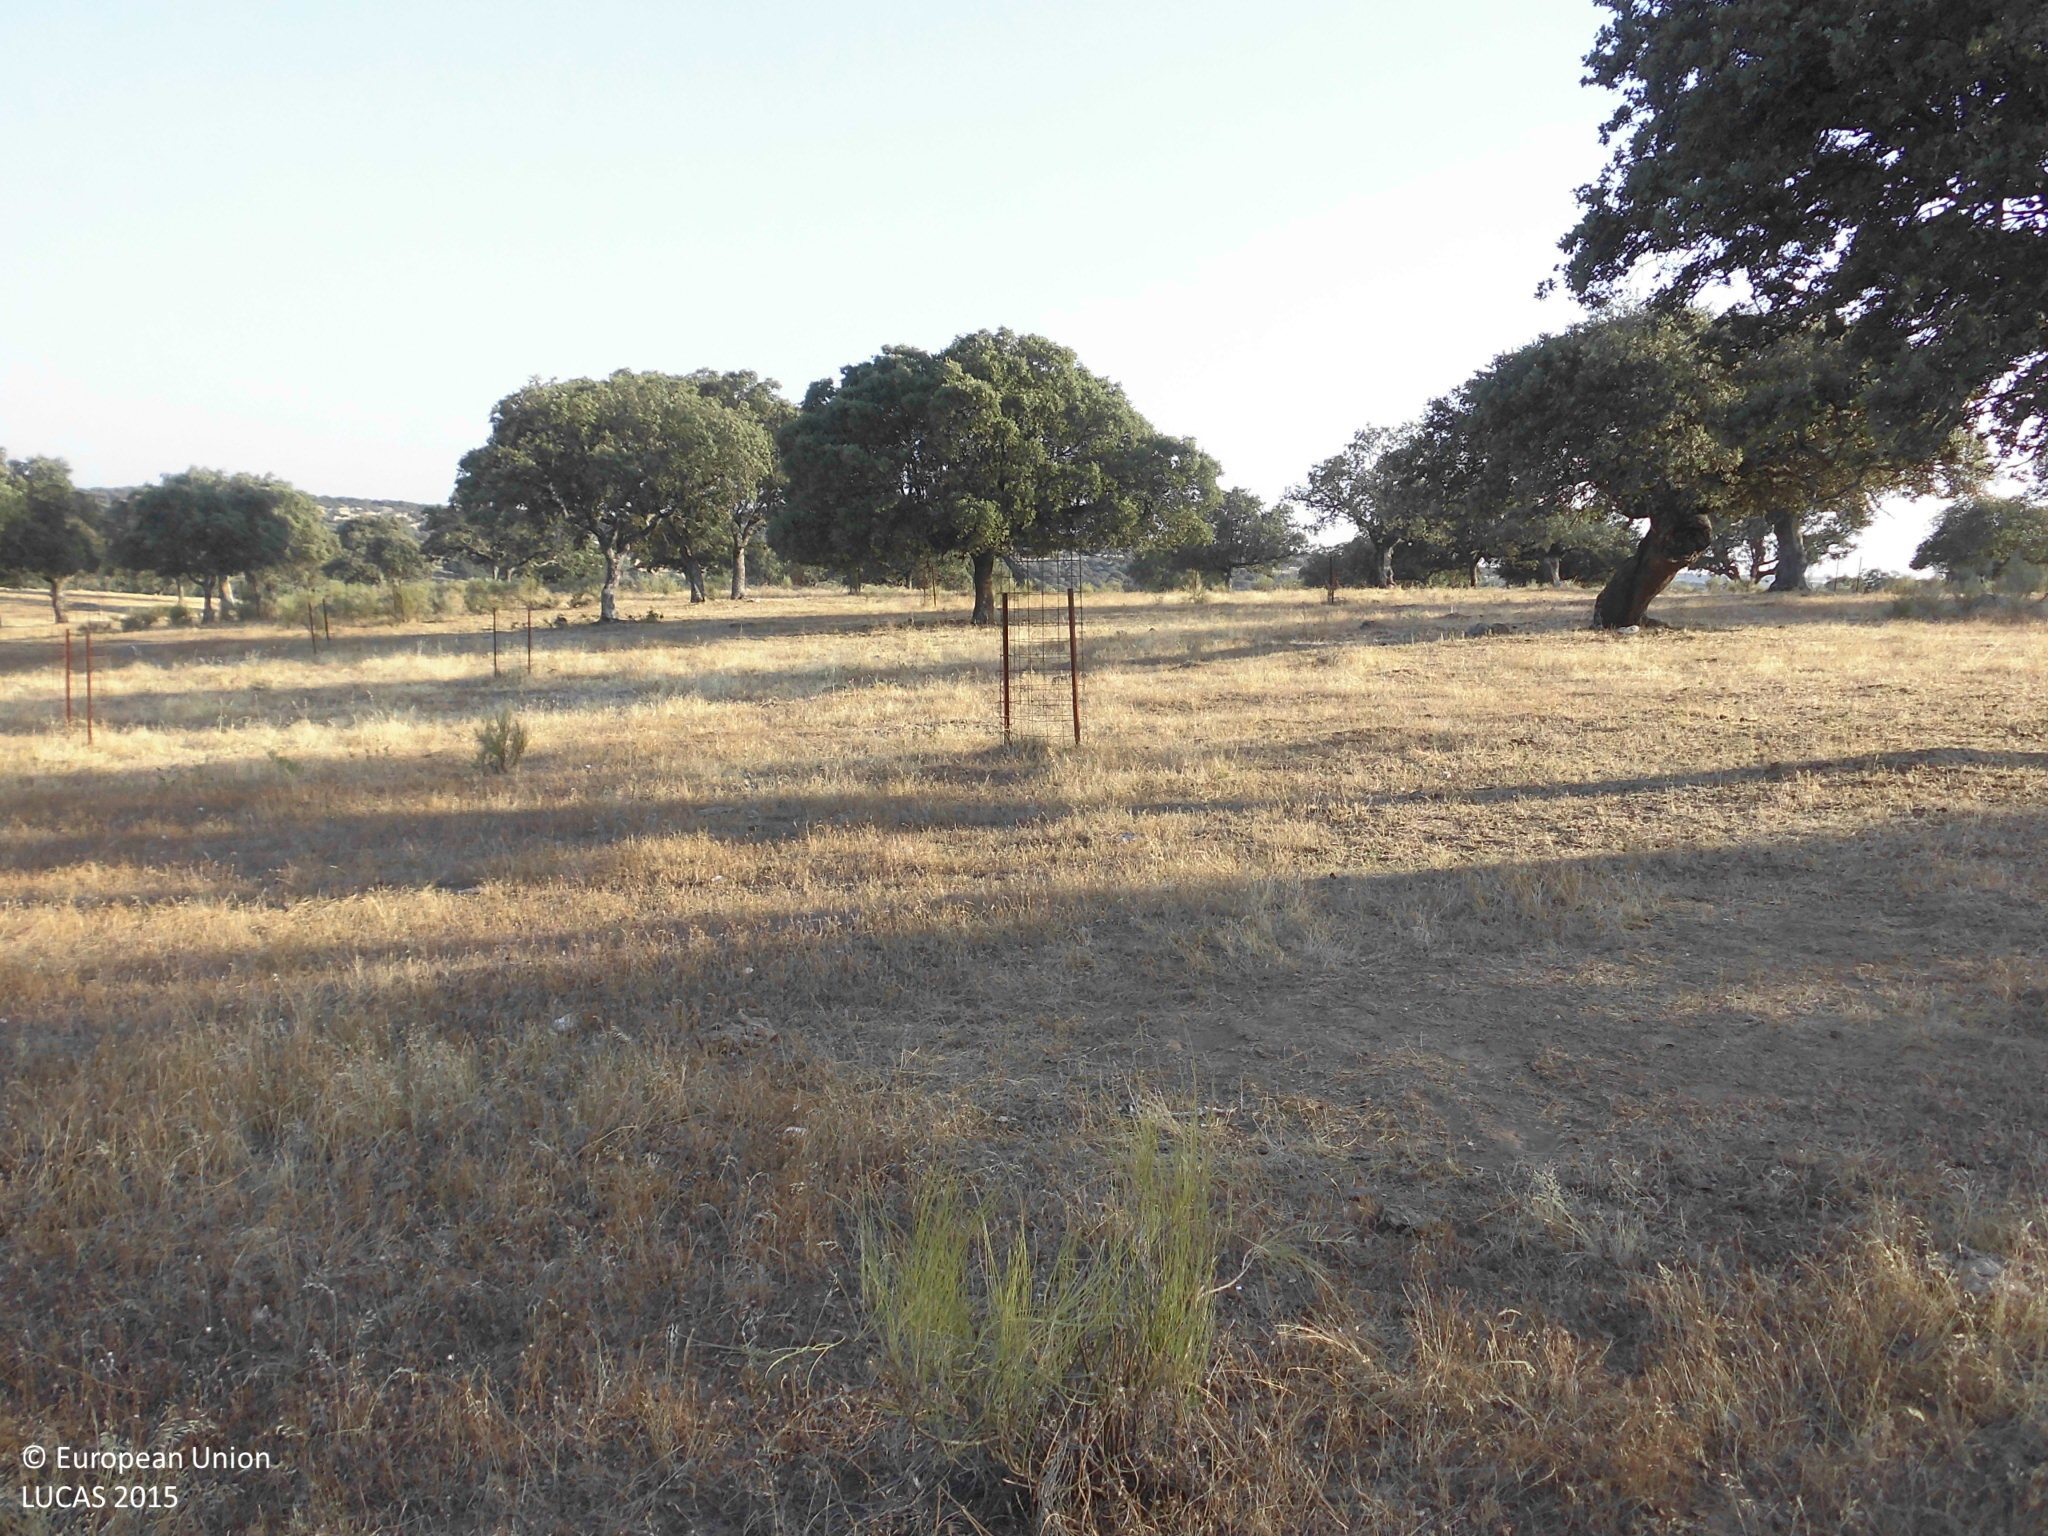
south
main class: Woodland
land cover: Broadleaved woodland
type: broadleaved evergreen forest
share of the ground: 10 - 25 %
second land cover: Grassland without tree/shrub cover
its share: > 75 %
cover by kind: herbaceous plants 90 %, broadleaved forest trees 10 %
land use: Forestry
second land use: Agriculture (excluding fallow land and kitchen gardens)
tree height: > 5 m
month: July
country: ES
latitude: 39.6269
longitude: -5.6563
